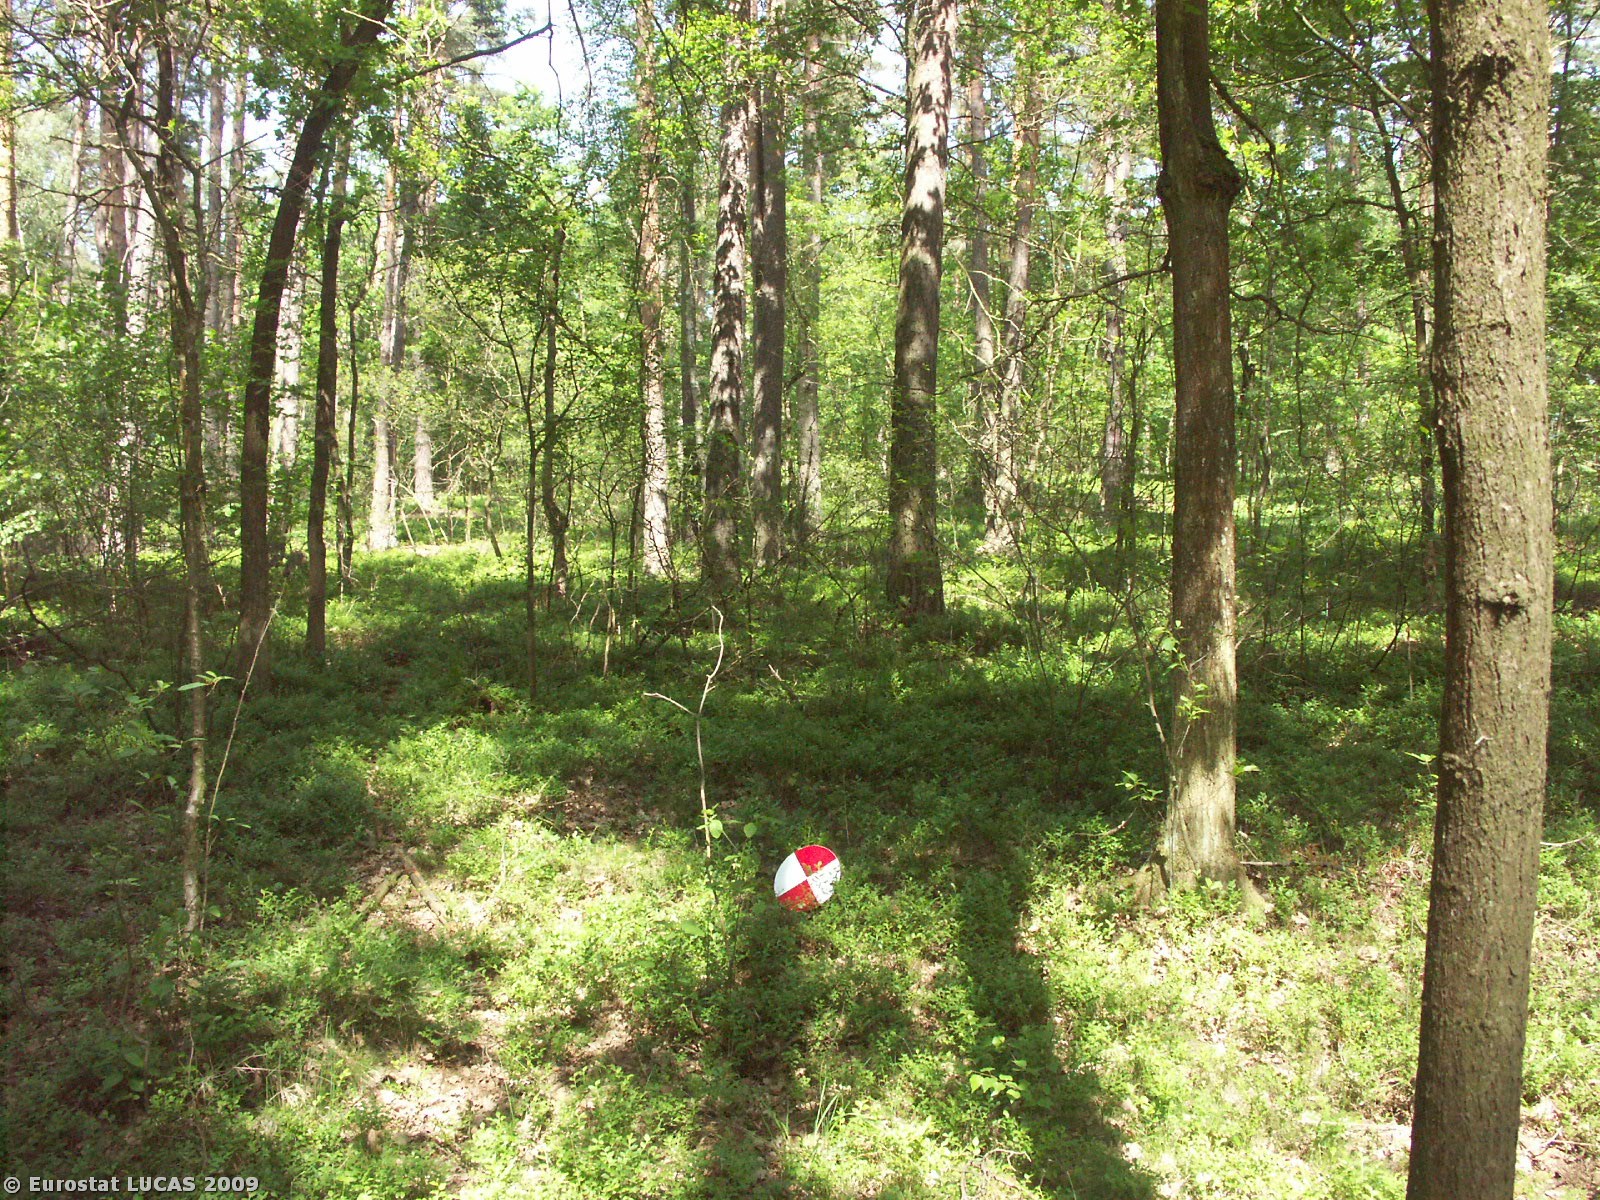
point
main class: Woodland
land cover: Mixed woodland
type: hemiboreal forest and nemoral coniferous forest and mixed broadleaved-coniferous forest
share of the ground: > 75 %
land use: Forestry
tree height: > 5 m
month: May
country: CZ
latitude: 49.0259
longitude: 14.6650
